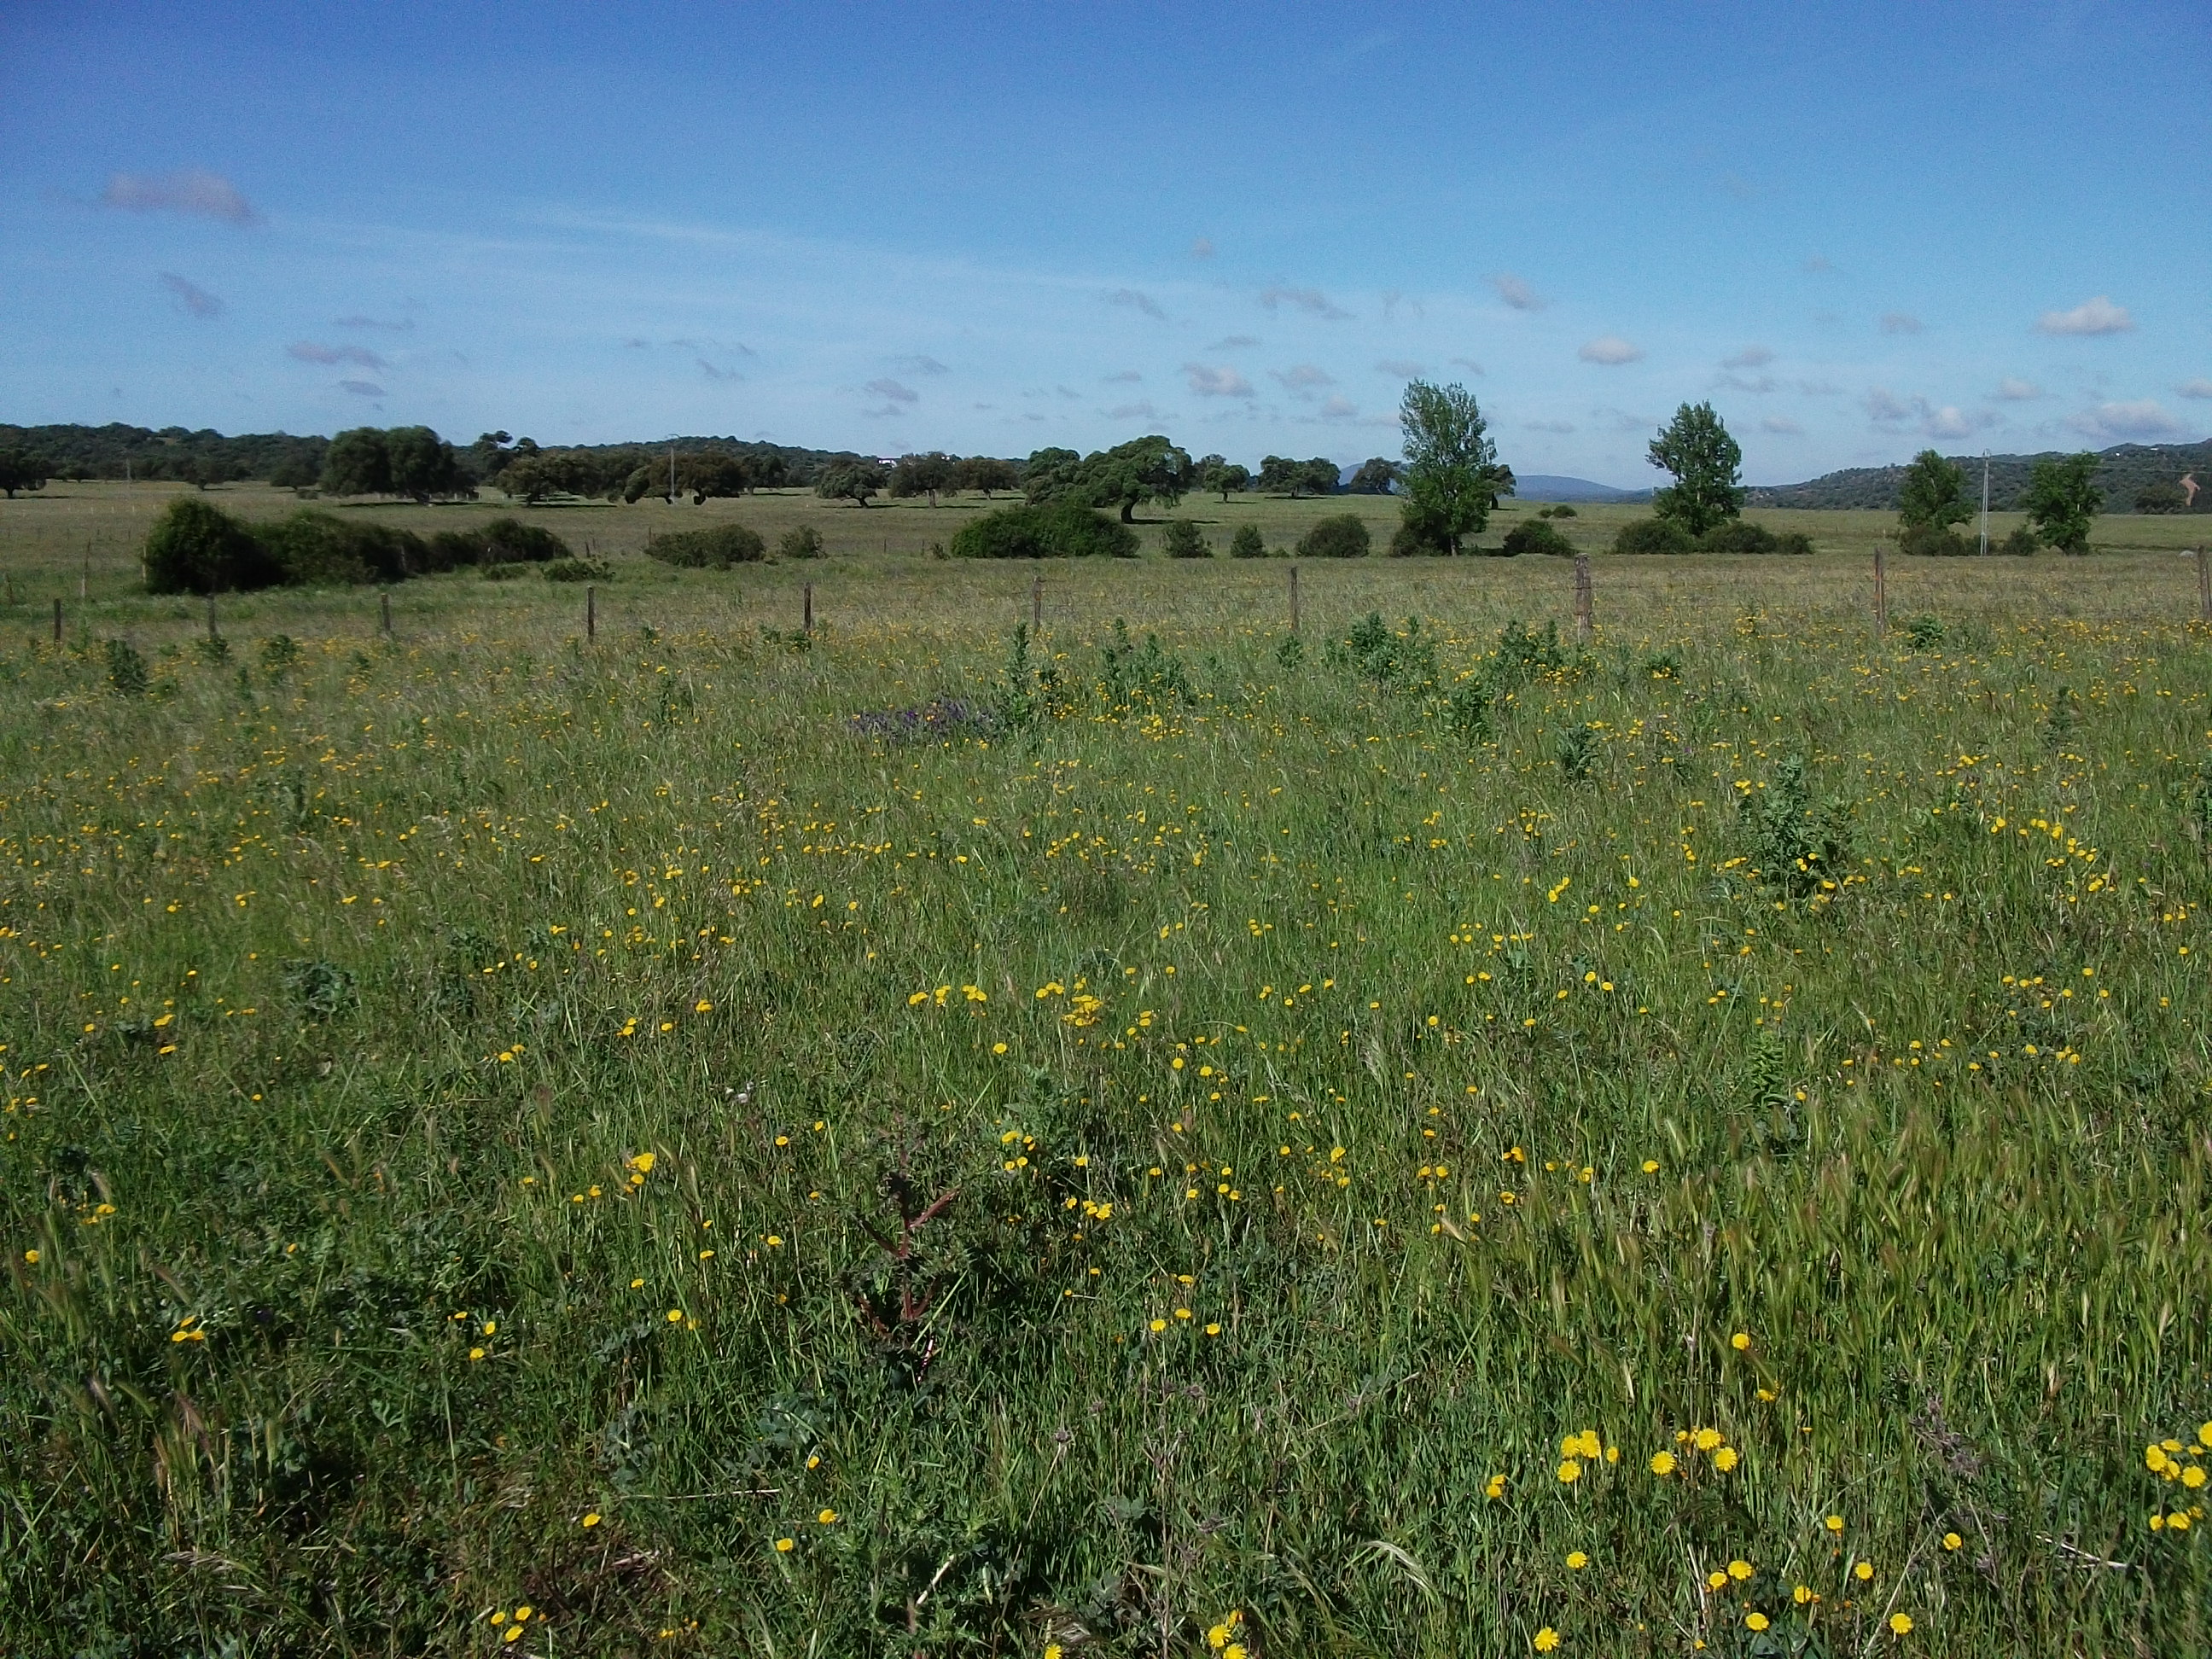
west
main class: Grassland
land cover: Grassland without tree/shrub cover
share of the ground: > 75 %
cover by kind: herbaceous plants 100 %
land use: Agriculture (excluding fallow land and kitchen gardens)
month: April
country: ES
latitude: 37.9786
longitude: -7.0984
